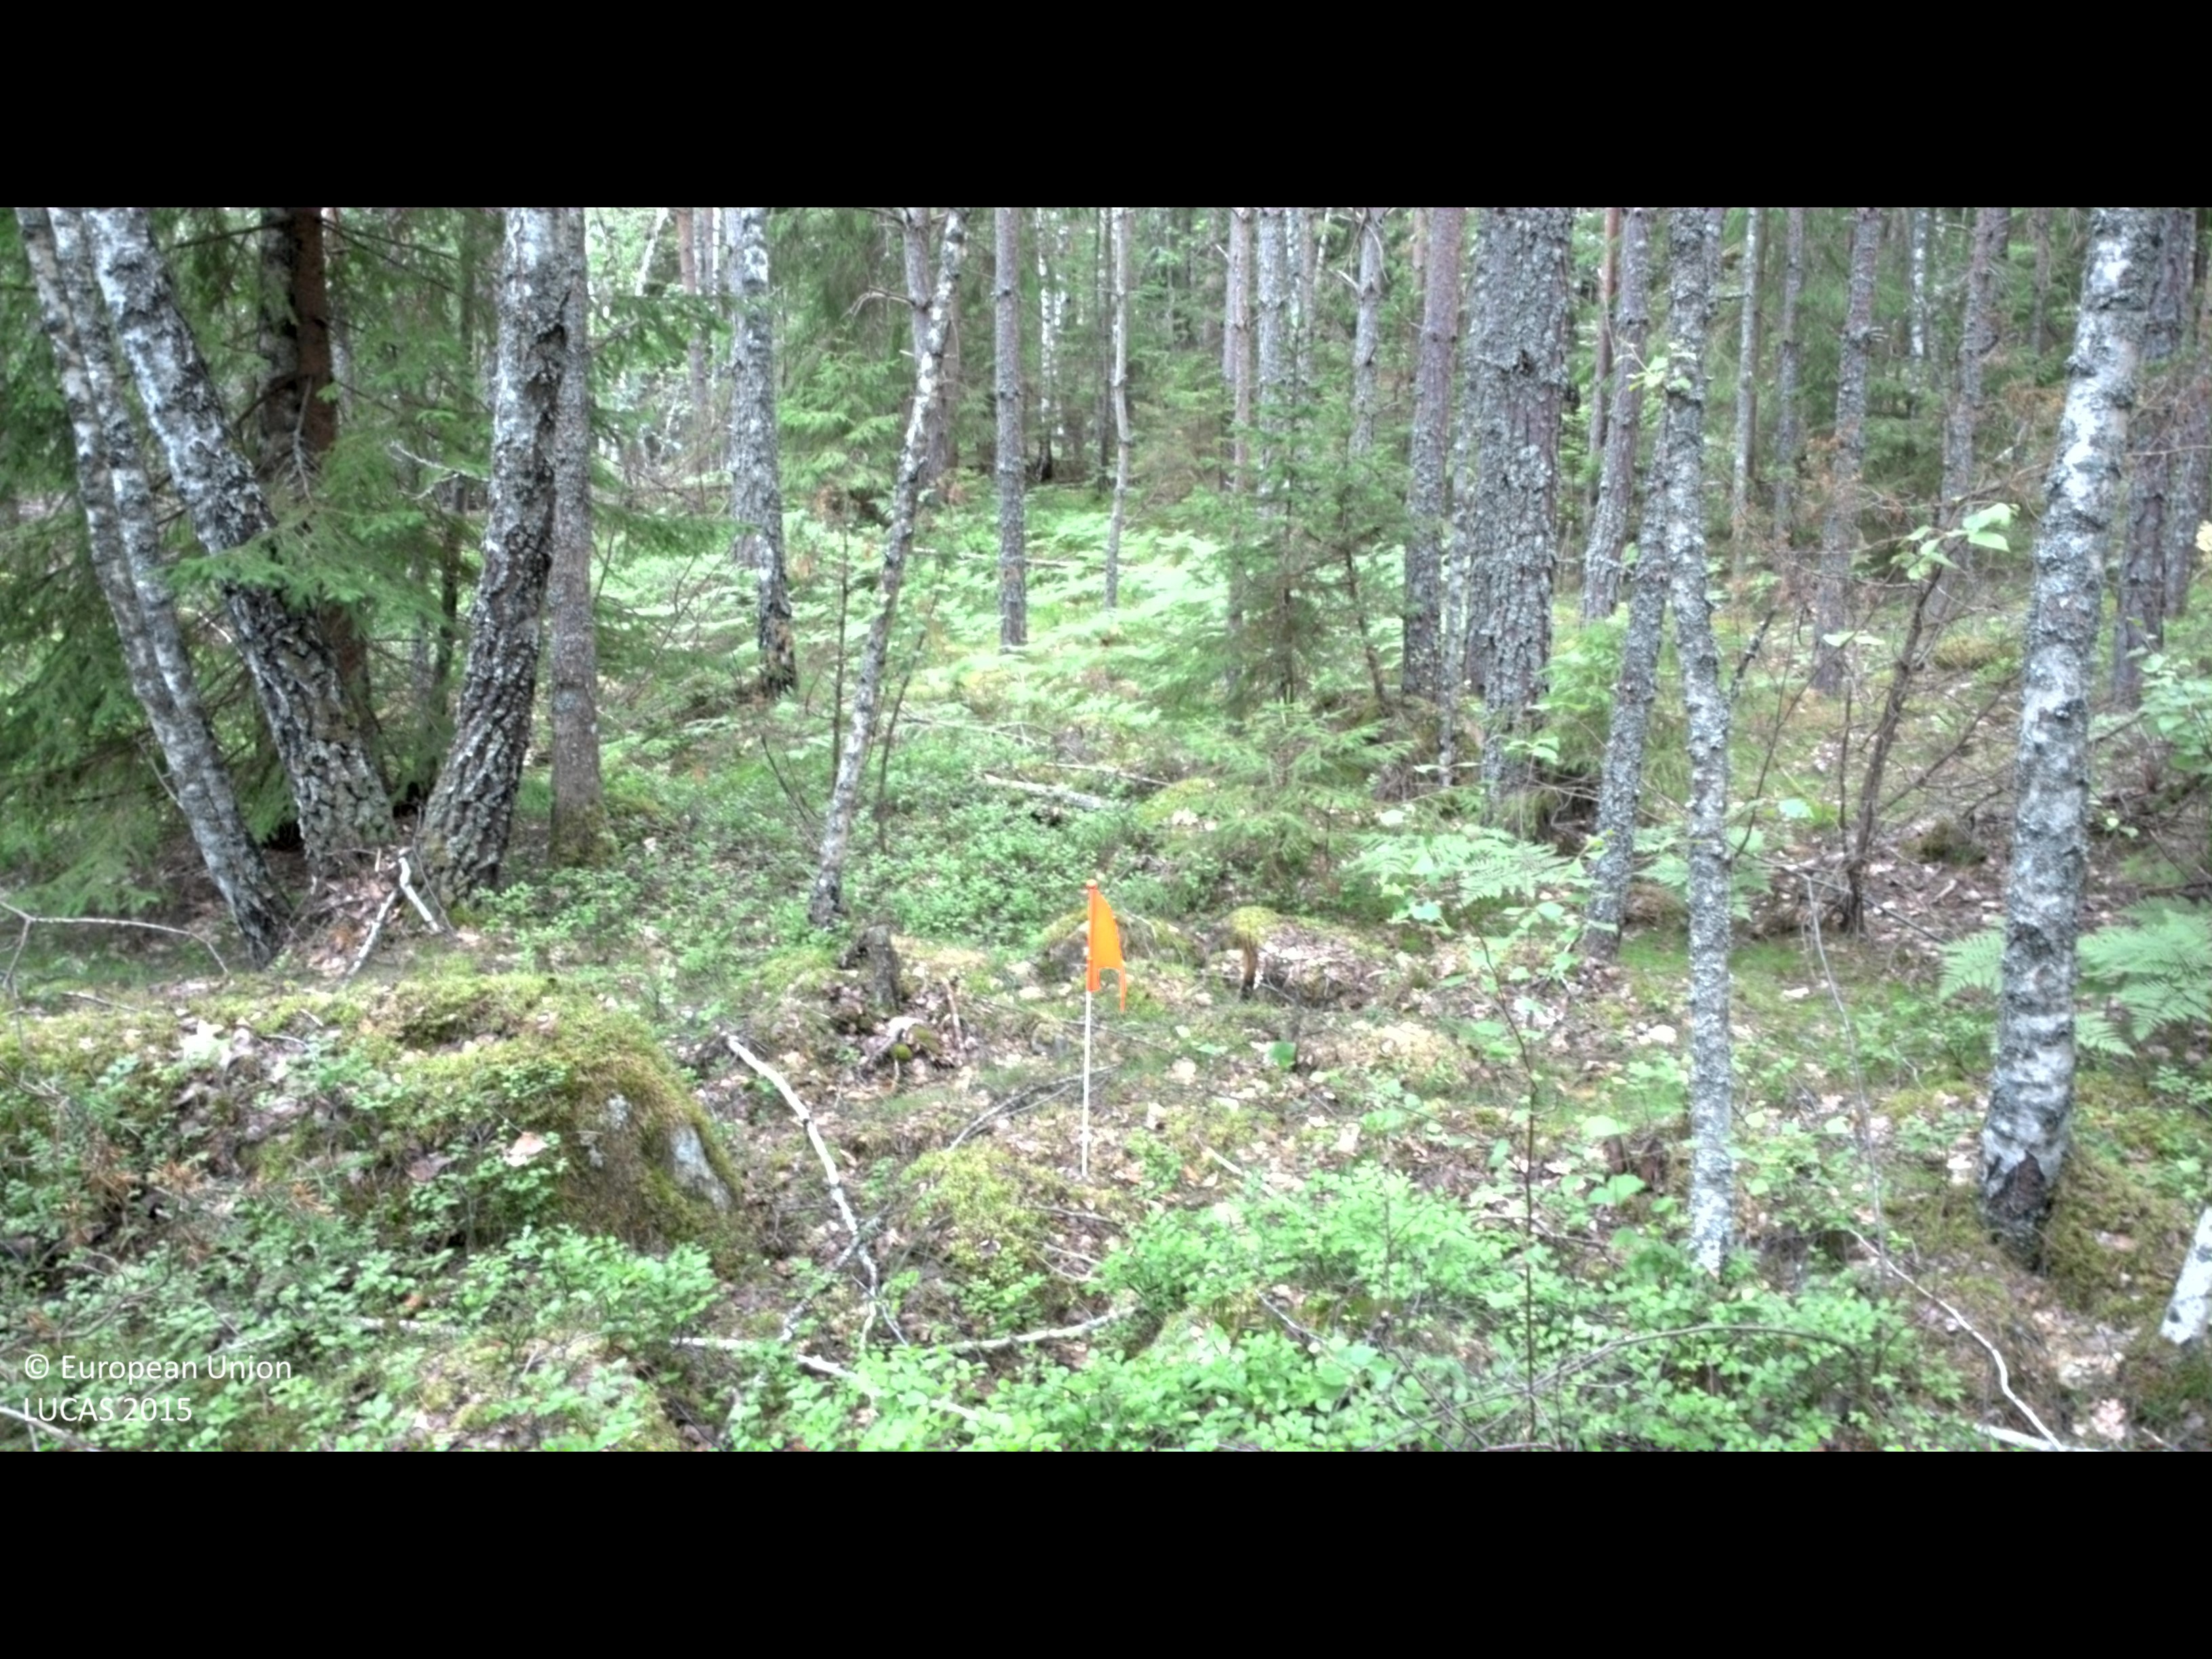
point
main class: Woodland
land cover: Pine dominated mixed woodland
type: boreal forest
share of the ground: > 75 %
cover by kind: coniferous forest trees 50 %, broadleaved forest trees 30 %, shrubs 10 %, herbaceous plants 5 %, lichens and mosses 5 %
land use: Forestry
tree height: > 5 m
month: June
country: SE
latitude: 58.1604
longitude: 16.3360
